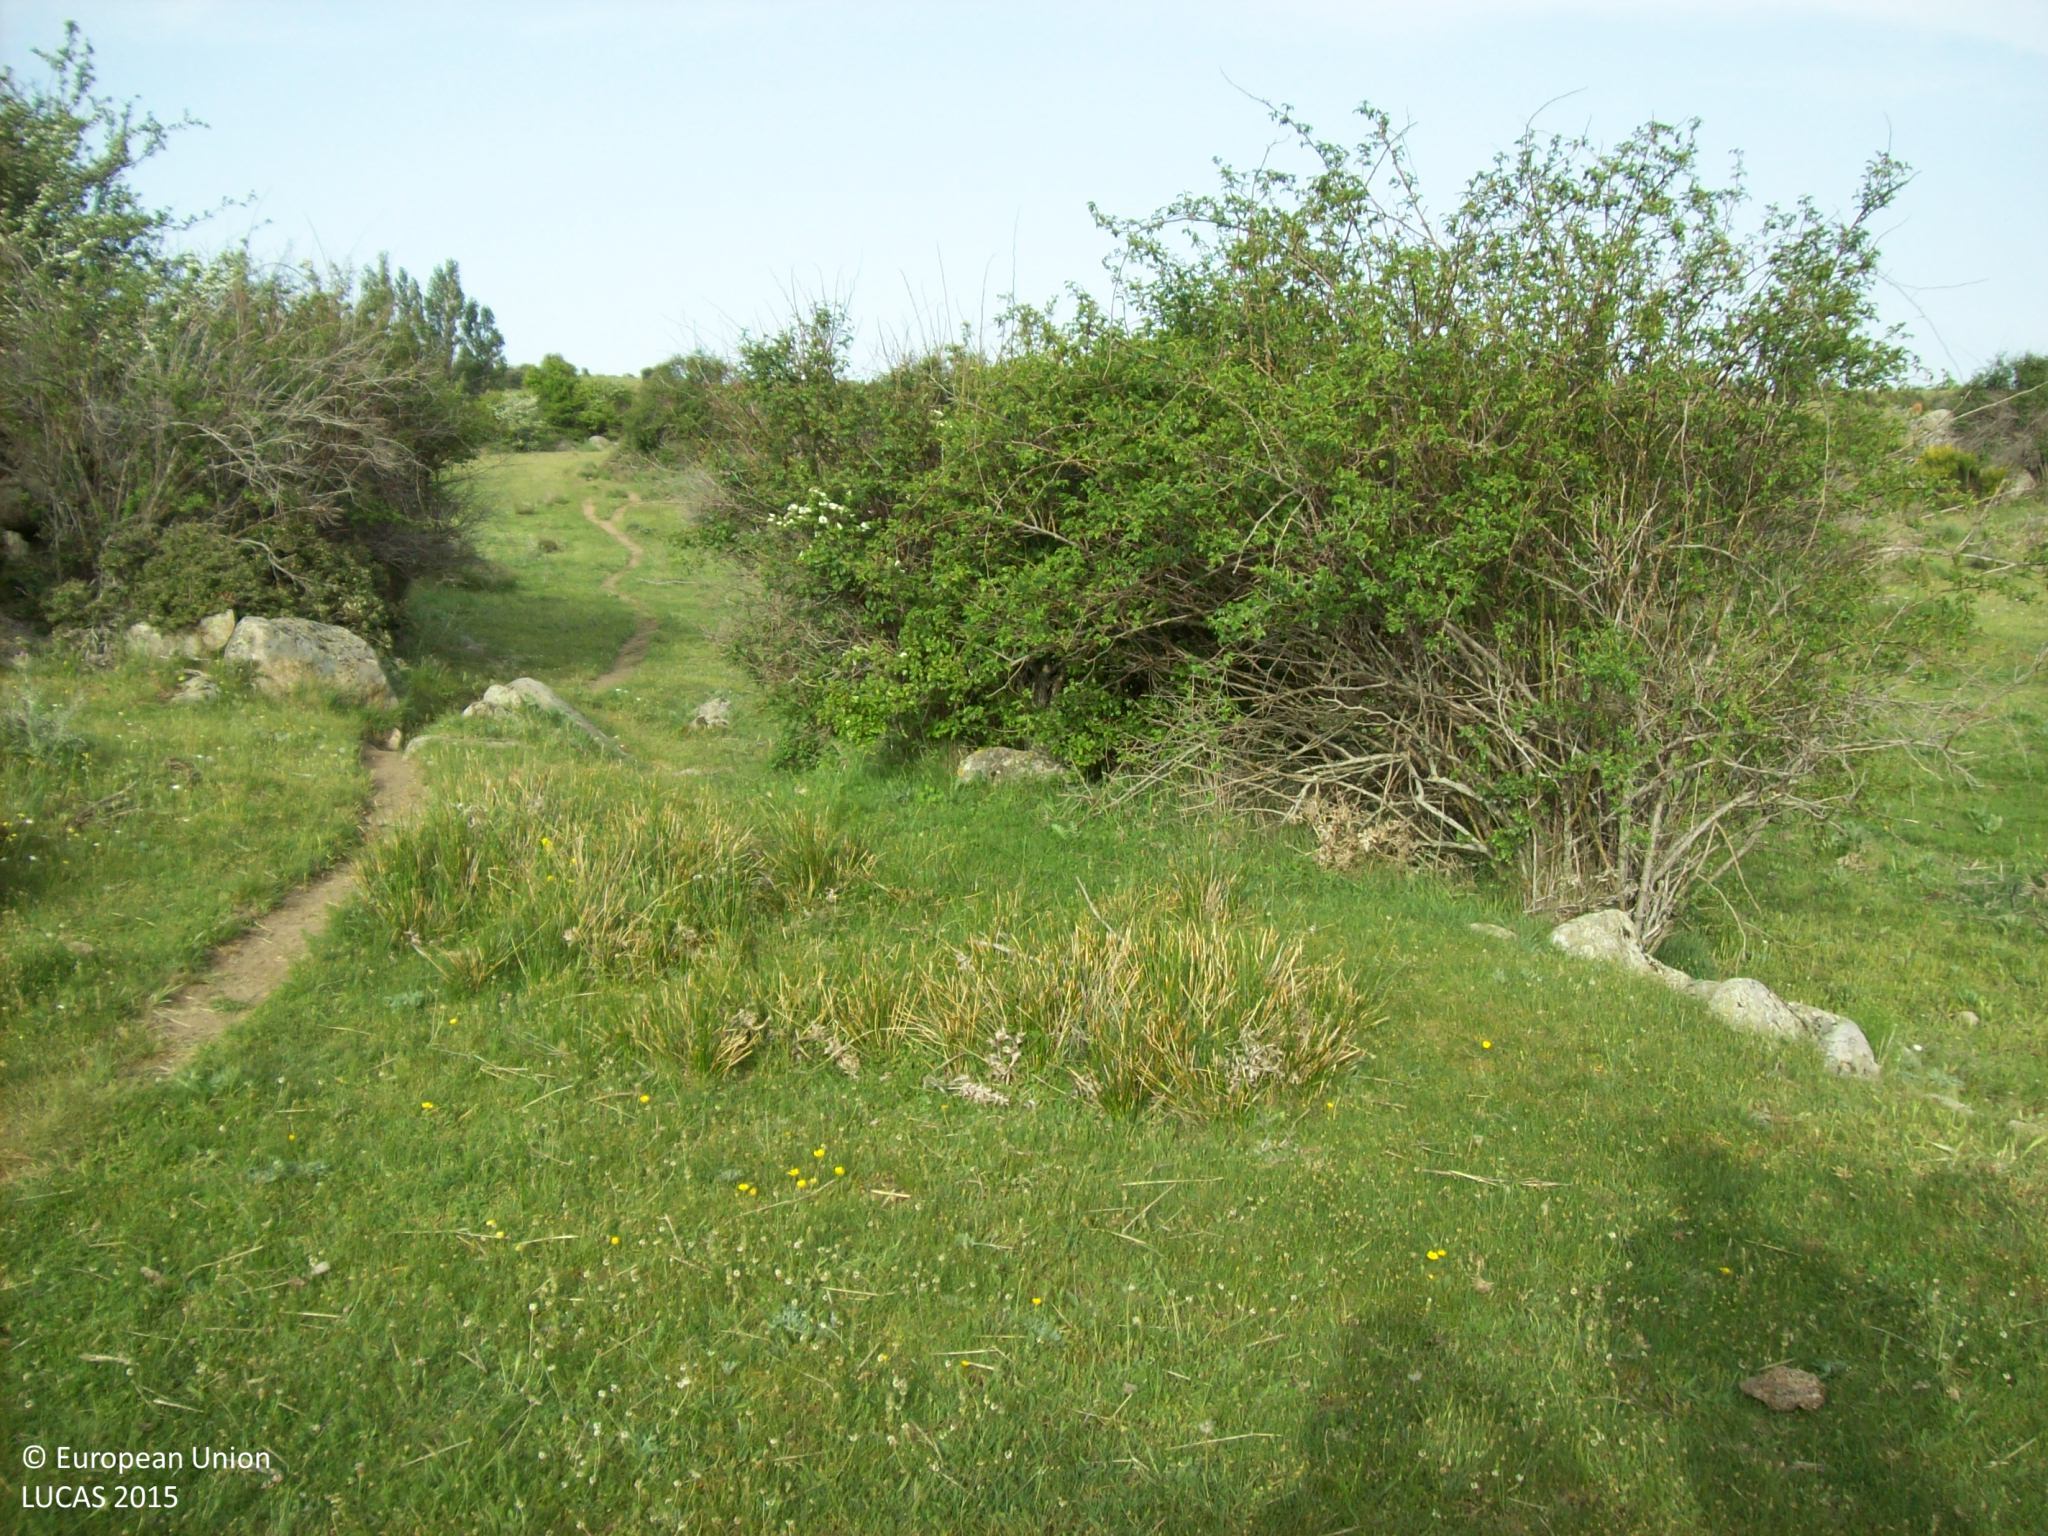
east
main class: Shrubland
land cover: Shrubland without tree cover
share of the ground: 10 - 25 %
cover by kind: herbaceous plants 75 %, shrubs 15 %, consolidated bare surface 10 %
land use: Agriculture (excluding fallow land and kitchen gardens)
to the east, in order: Shrubland without tree cover; Rock outcrops; Shrubland without tree cover; Abandoned hedges; Tracks; Grassland with sparse tree/shrub cover
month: May
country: ES
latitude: 40.7063
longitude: -4.8660
